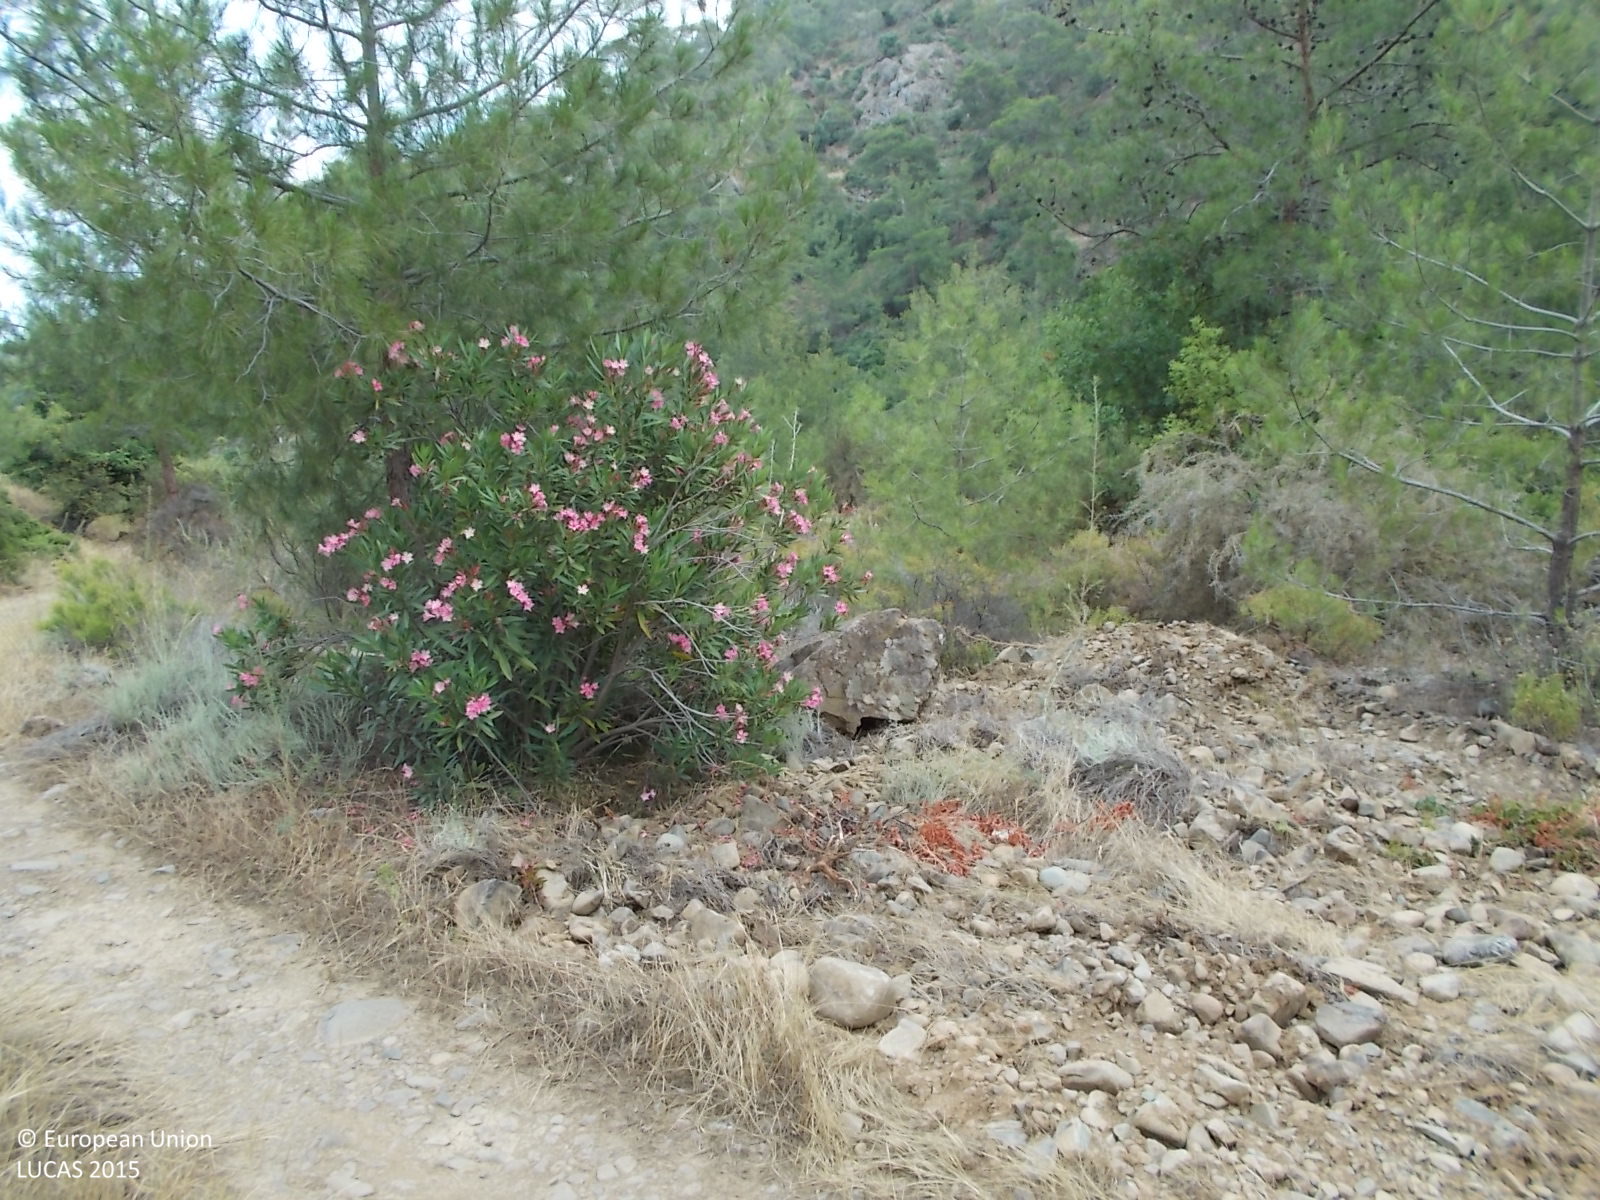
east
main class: Shrubland
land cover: Shrubland without tree cover
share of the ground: 25 - 50 %
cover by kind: shrubs 35 %, herbaceous plants 25 %, consolidated bare surface 20 %, unconsolidated bare surface 20 %
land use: Semi-natural and natural areas not in use
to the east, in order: Shrubland without tree cover; Spontaneously vegetated surfaces; Abandoned hedges; Spontaneously vegetated surfaces; Shrubland without tree cover; Tracks
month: June
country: CY
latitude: 35.1611
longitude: 32.6607
